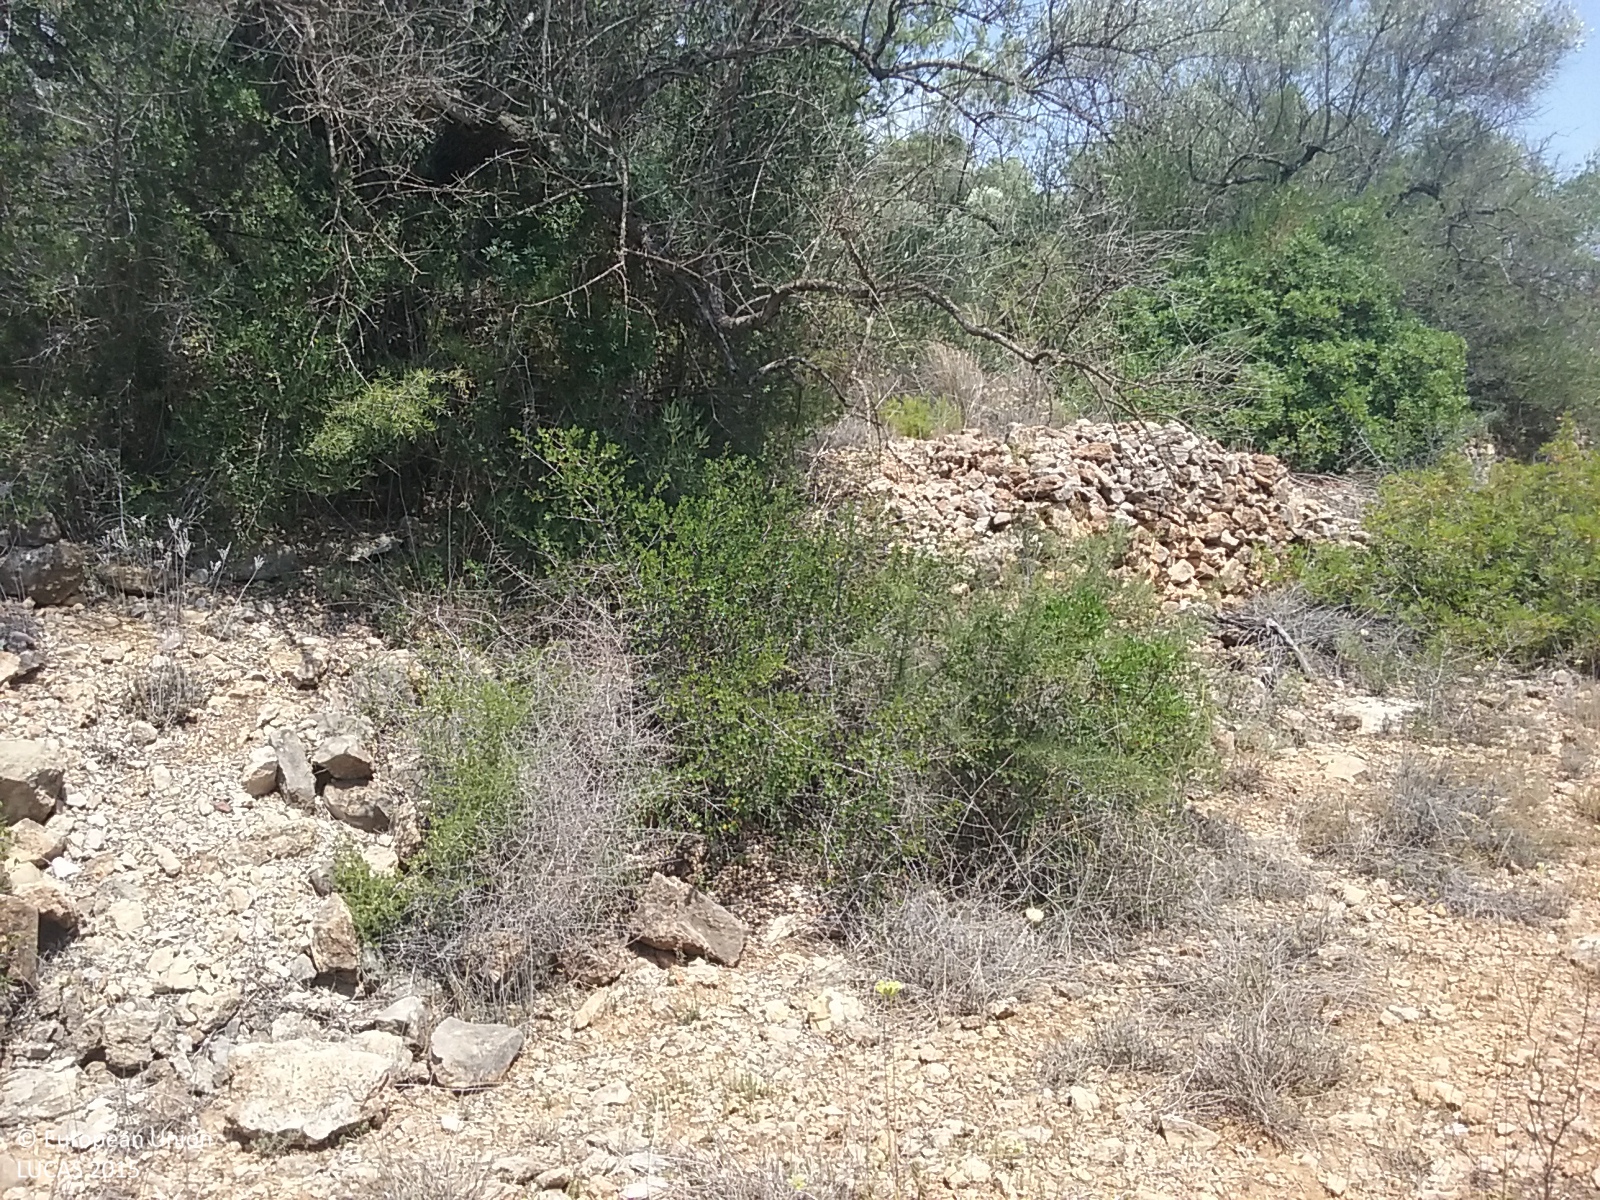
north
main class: Cropland
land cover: Olive groves
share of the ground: 25 - 50 %
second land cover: Grassland without tree/shrub cover
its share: 50 - 75 %
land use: Abandoned areas
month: July
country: ES
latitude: 40.1495
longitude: -0.0629
